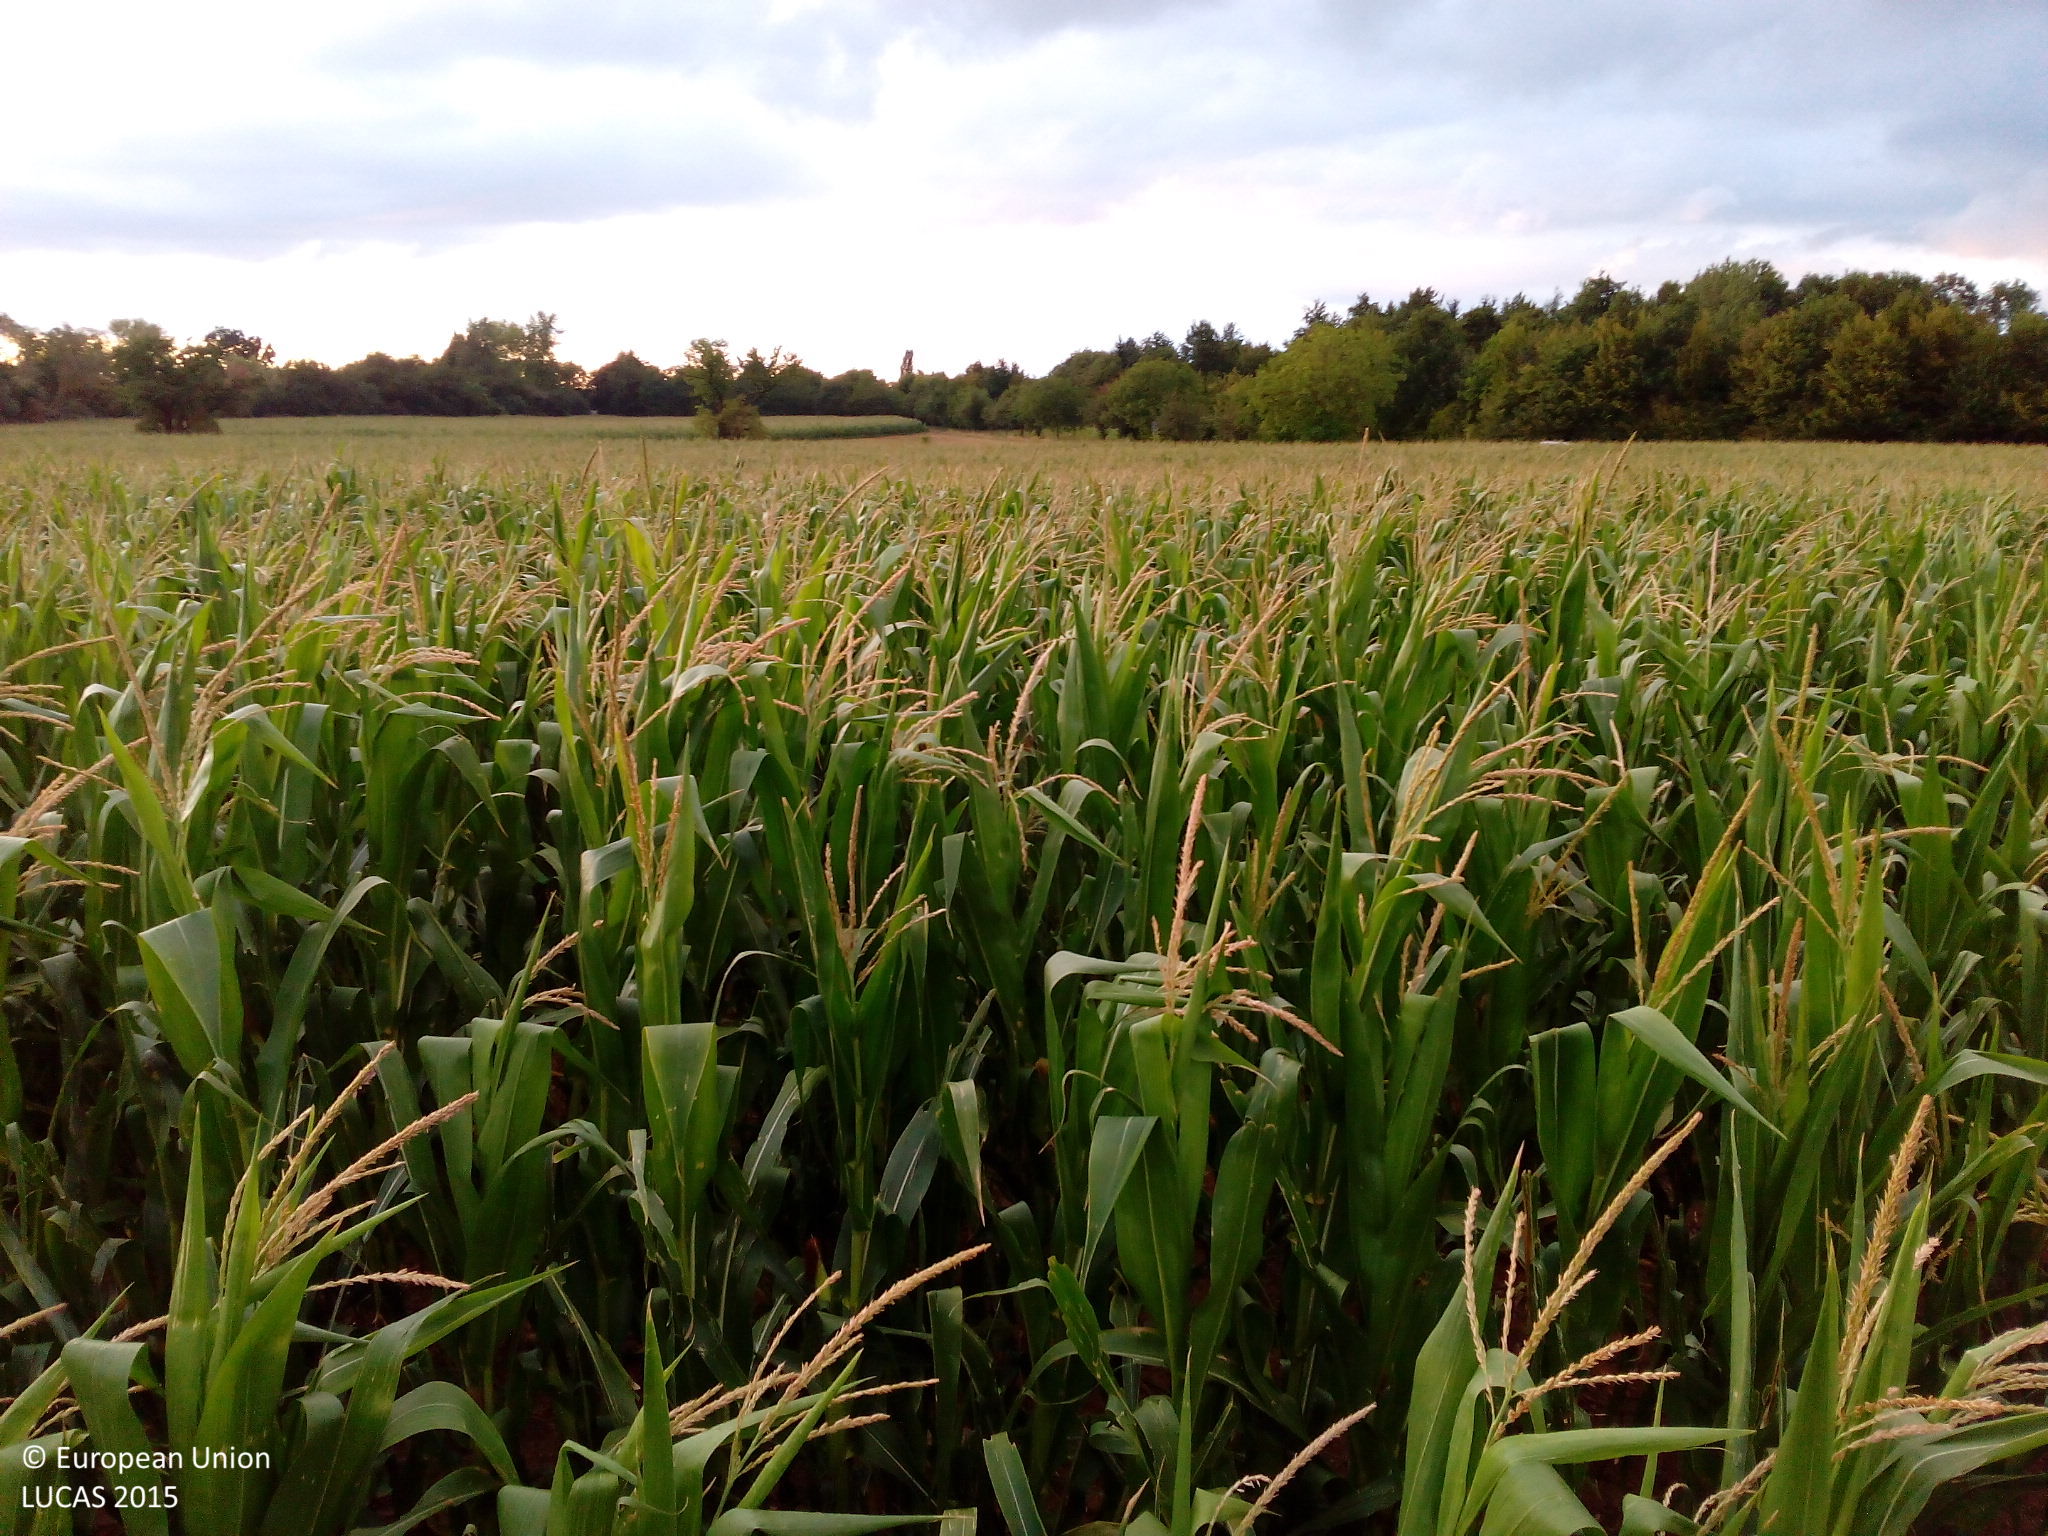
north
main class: Cropland
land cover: Maize
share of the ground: > 75 %
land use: Agriculture (excluding fallow land and kitchen gardens)
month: August
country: DE
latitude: 49.4389
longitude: 8.6627
